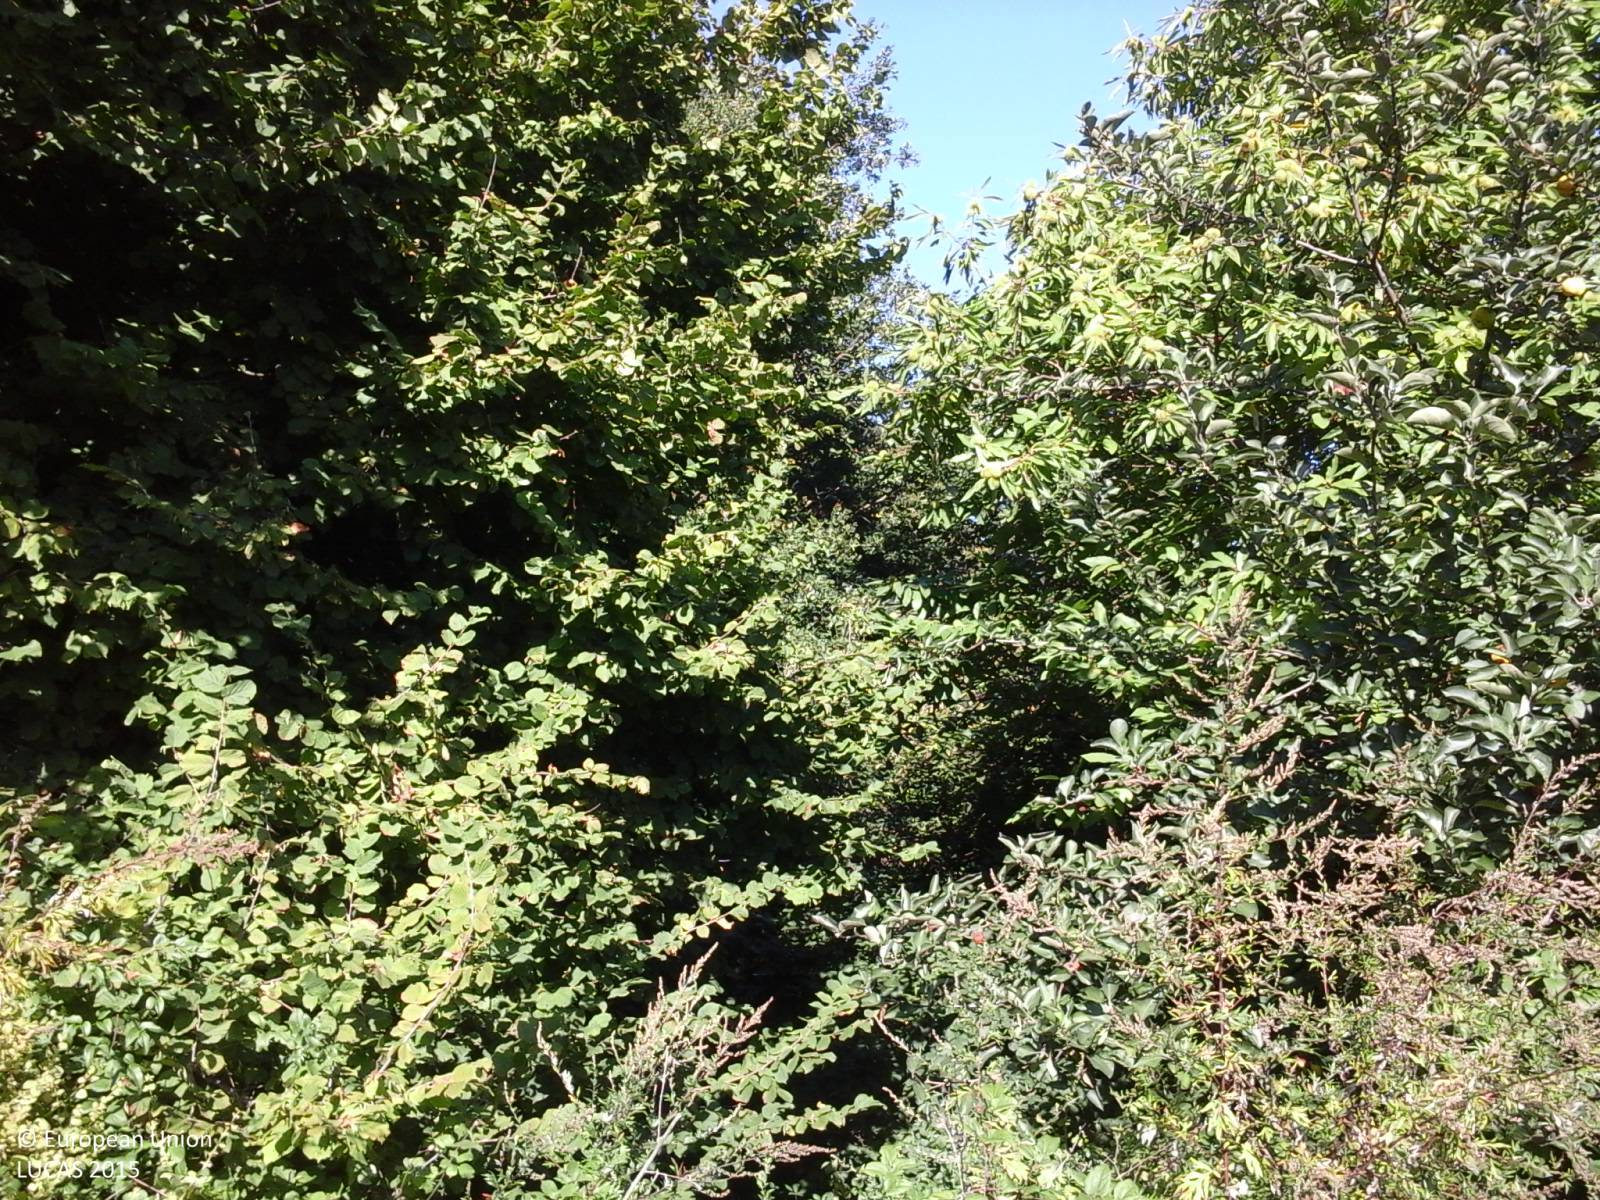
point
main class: Woodland
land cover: Broadleaved woodland
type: thermophilous deciduous forest
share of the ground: > 75 %
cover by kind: broadleaved forest trees 90 %, shrubs 10 %
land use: Forestry
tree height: > 5 m
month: September
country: IT
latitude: 42.7235
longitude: 12.0572
